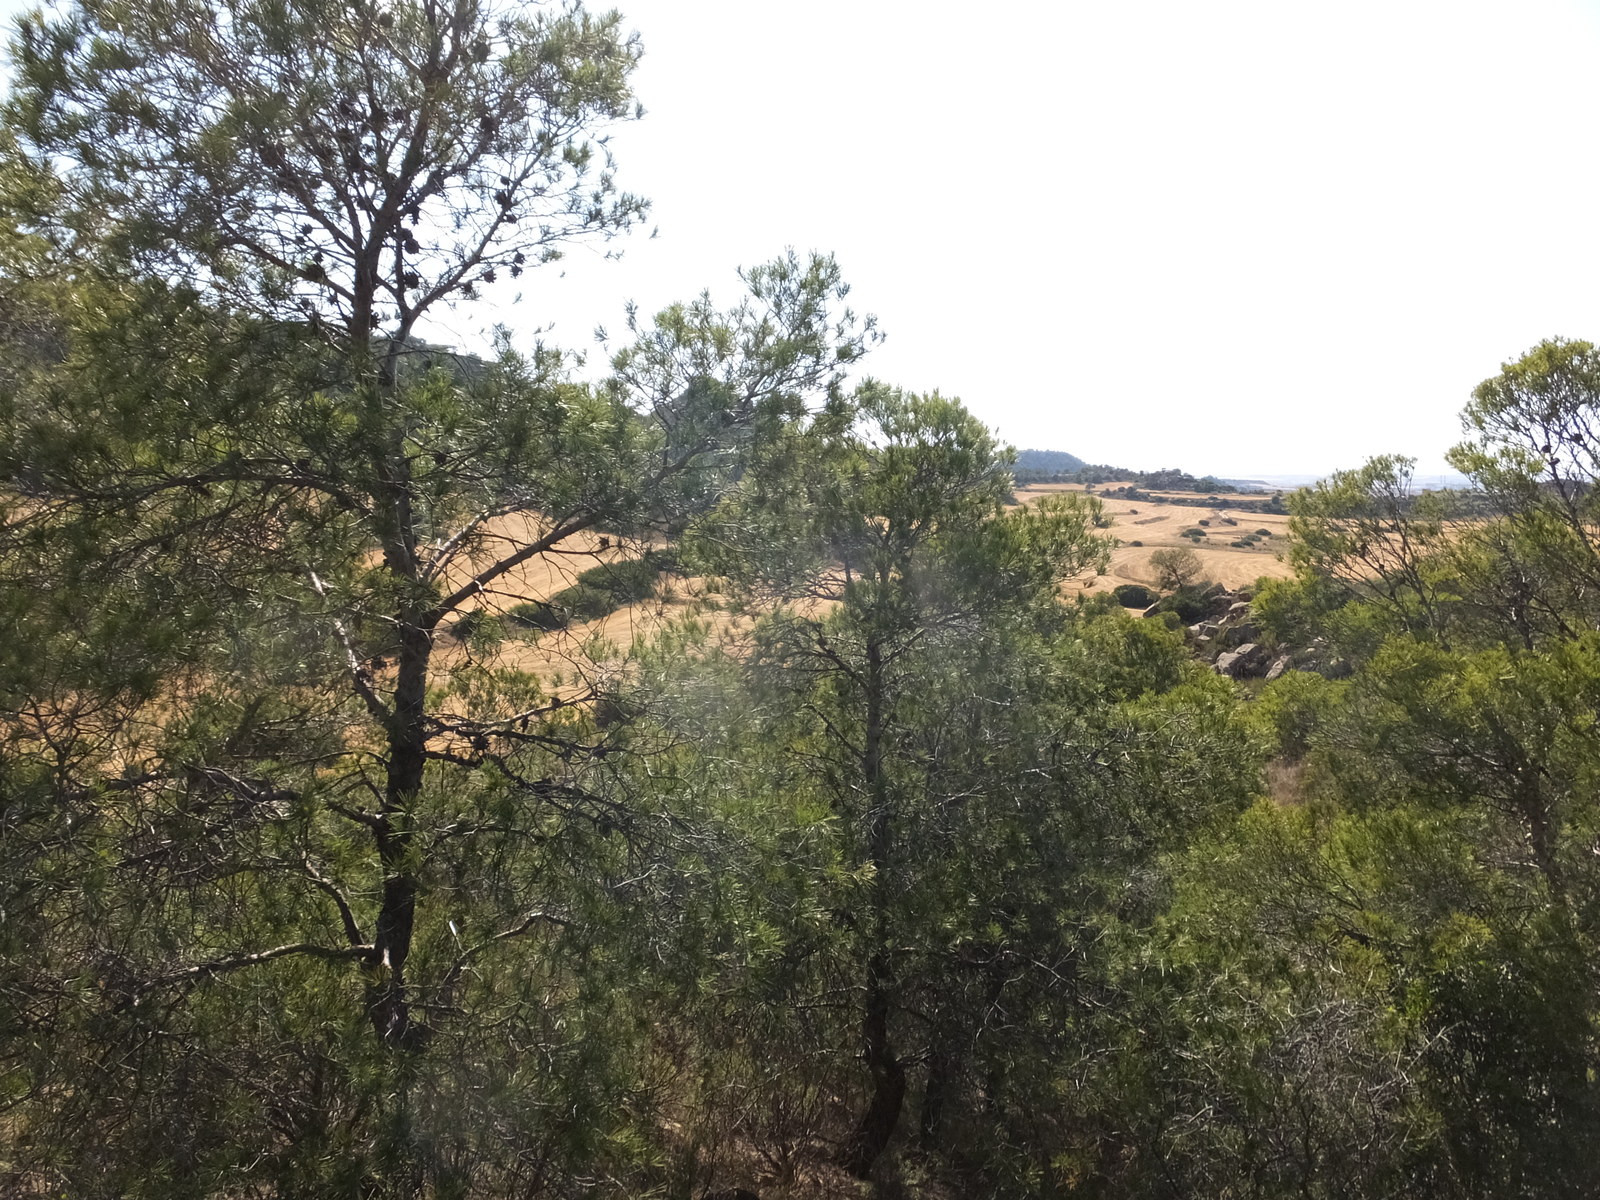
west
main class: Woodland
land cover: Pine dominated mixed woodland
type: coniferous forest of the mediterranean region
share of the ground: 50 - 75 %
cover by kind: coniferous forest trees 60 %, broadleaved forest trees 20 %, shrubs 10 %, herbaceous plants 10 %
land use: Forestry
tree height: > 5 m
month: June
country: ES
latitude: 41.1884
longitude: -0.2308
